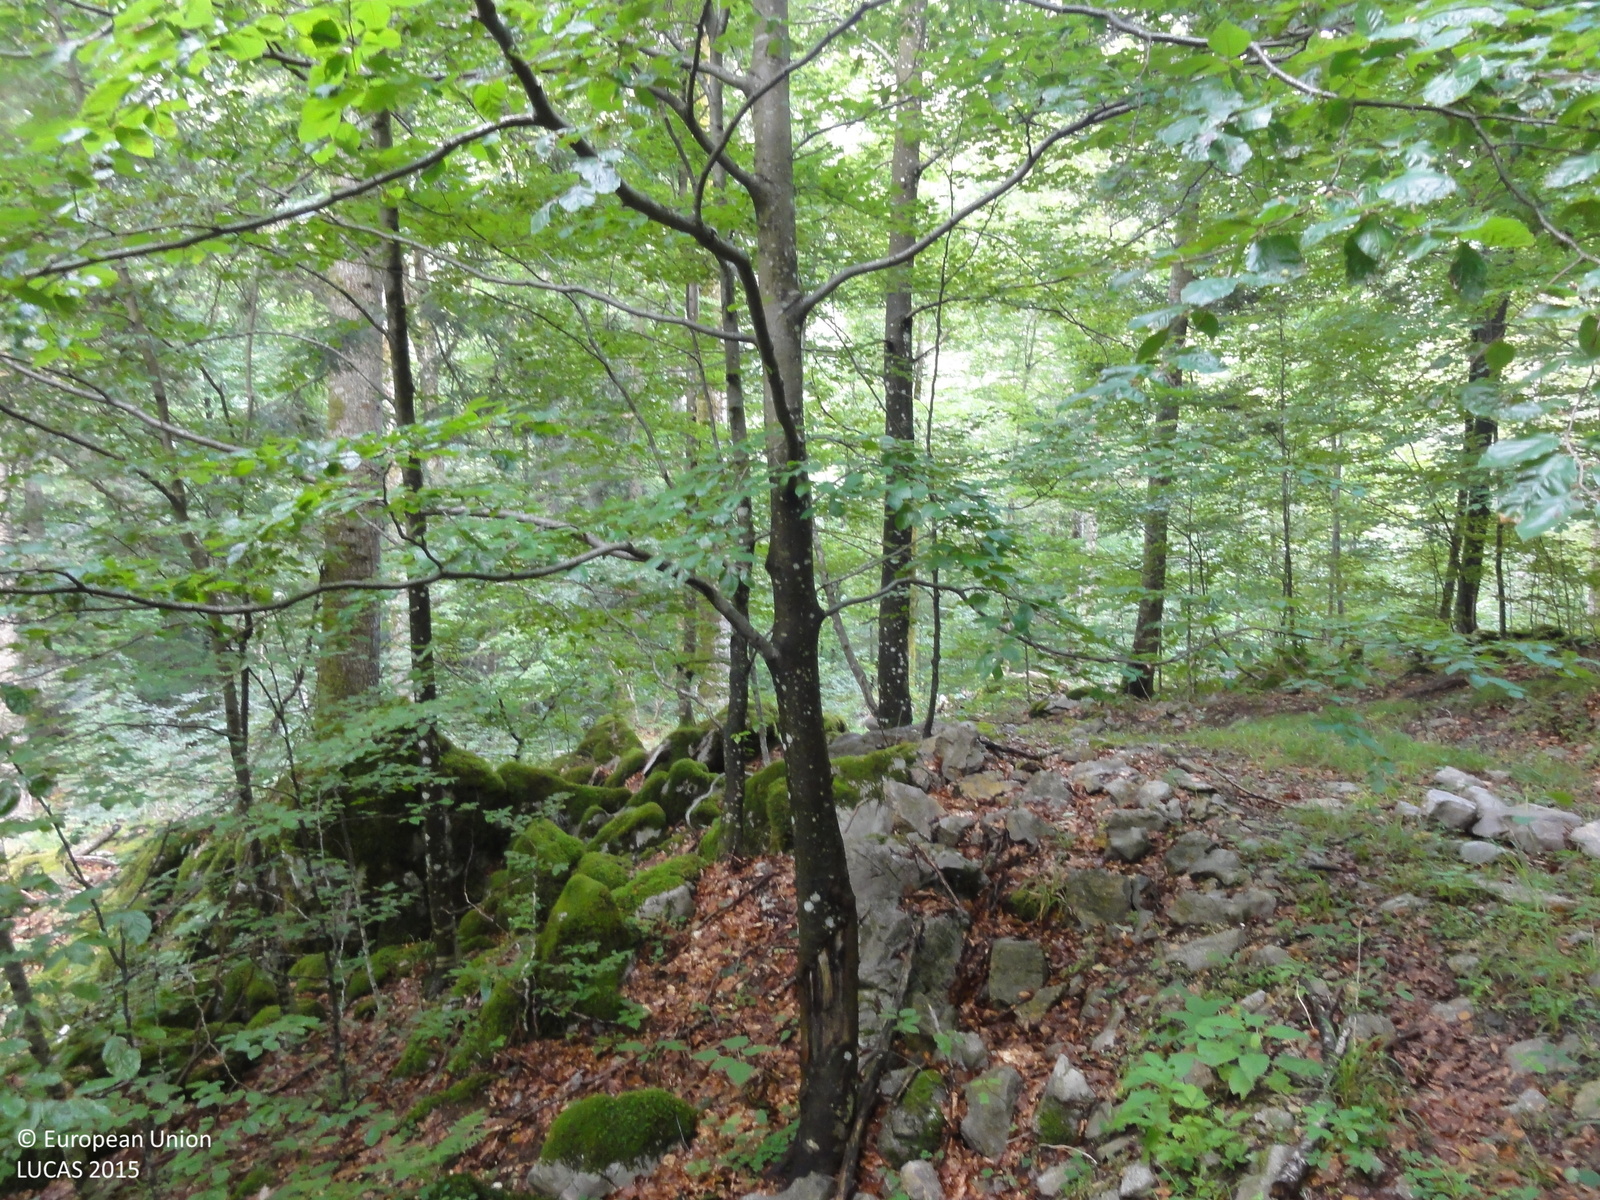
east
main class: Woodland
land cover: Spruce dominated mixed woodland
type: mountainous beech forest
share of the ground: > 75 %
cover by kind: broadleaved forest trees 60 %, coniferous forest trees 25 %, herbaceous plants 10 %, shrubs 5 %
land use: Forestry
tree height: > 5 m
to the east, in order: Spruce dominated mixed woodland; Tracks; Spruce dominated mixed woodland; Tracks; Spruce dominated mixed woodland; Tracks; Spruce dominated mixed woodland
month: July
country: SI
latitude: 45.6296
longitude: 14.8060
